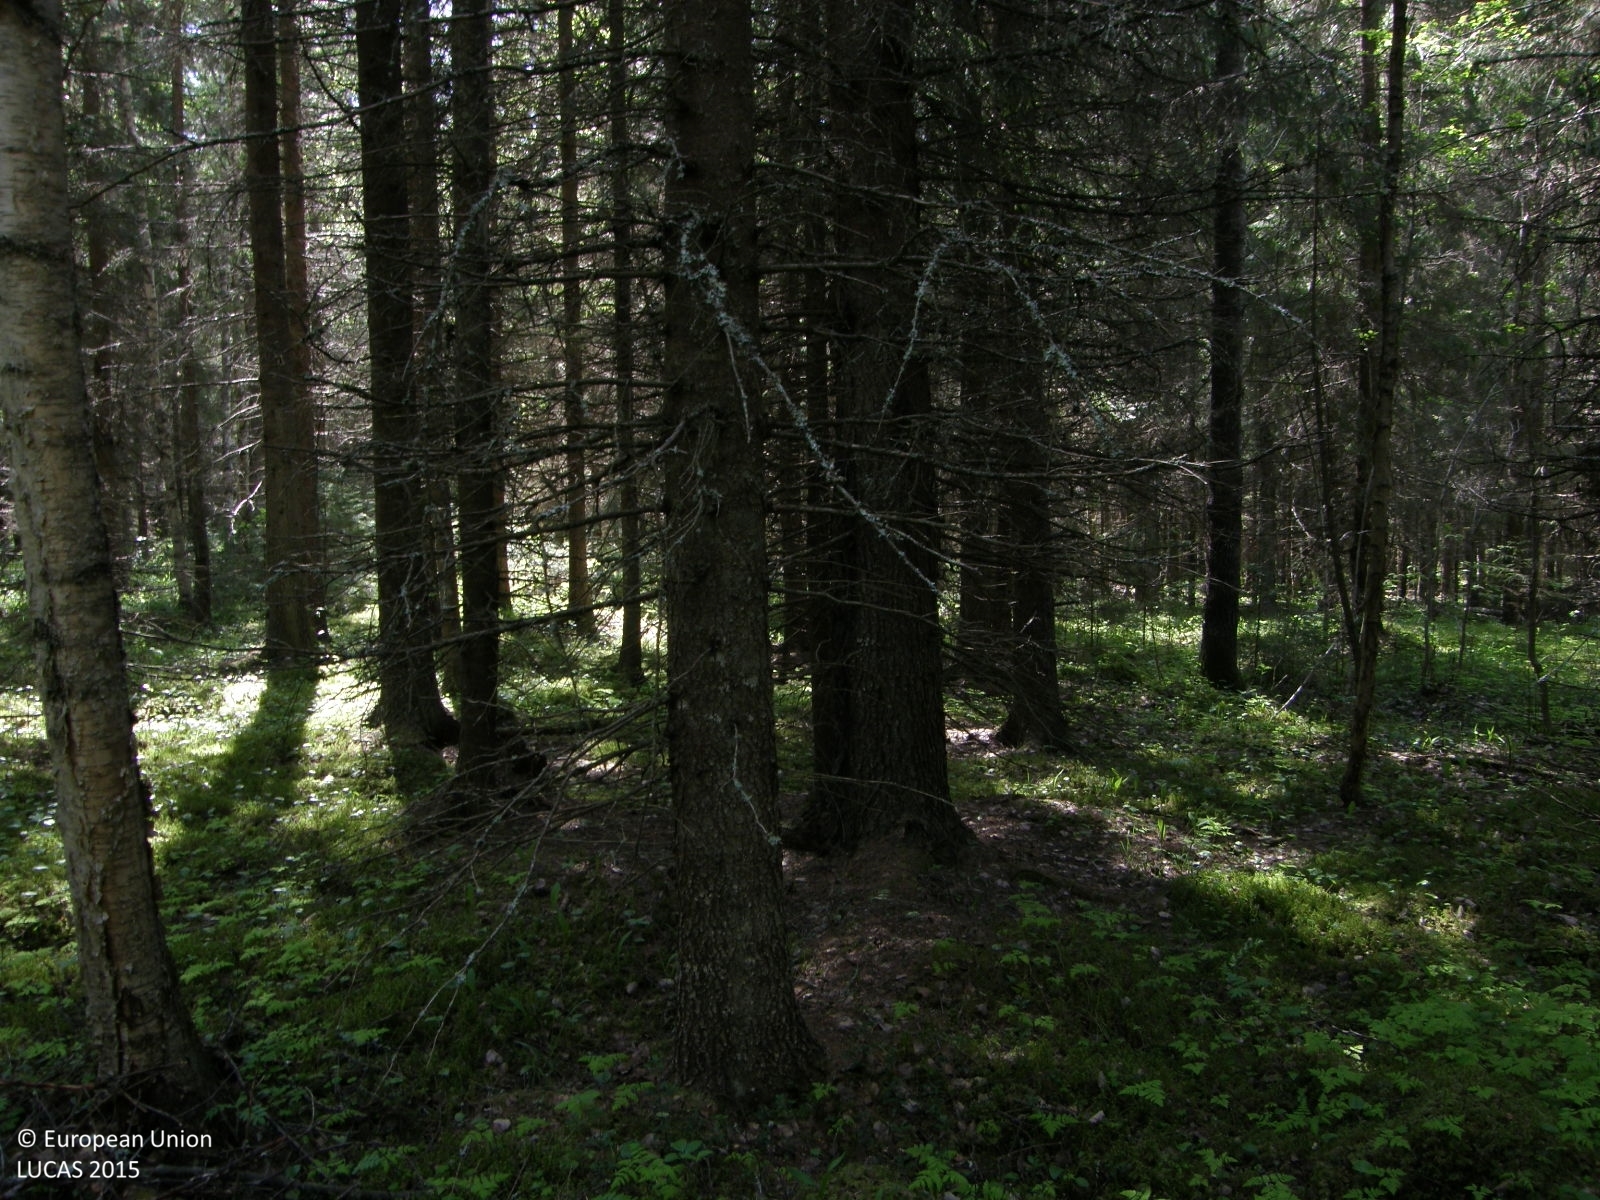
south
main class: Woodland
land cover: Spruce dominated coniferous woodland
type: boreal forest
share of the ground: > 75 %
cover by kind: coniferous forest trees 75 %, broadleaved forest trees 15 %, herbaceous plants 5 %, lichens and mosses 5 %
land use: Forestry
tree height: > 5 m
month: June
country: FI
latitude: 62.1341
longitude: 21.4953
